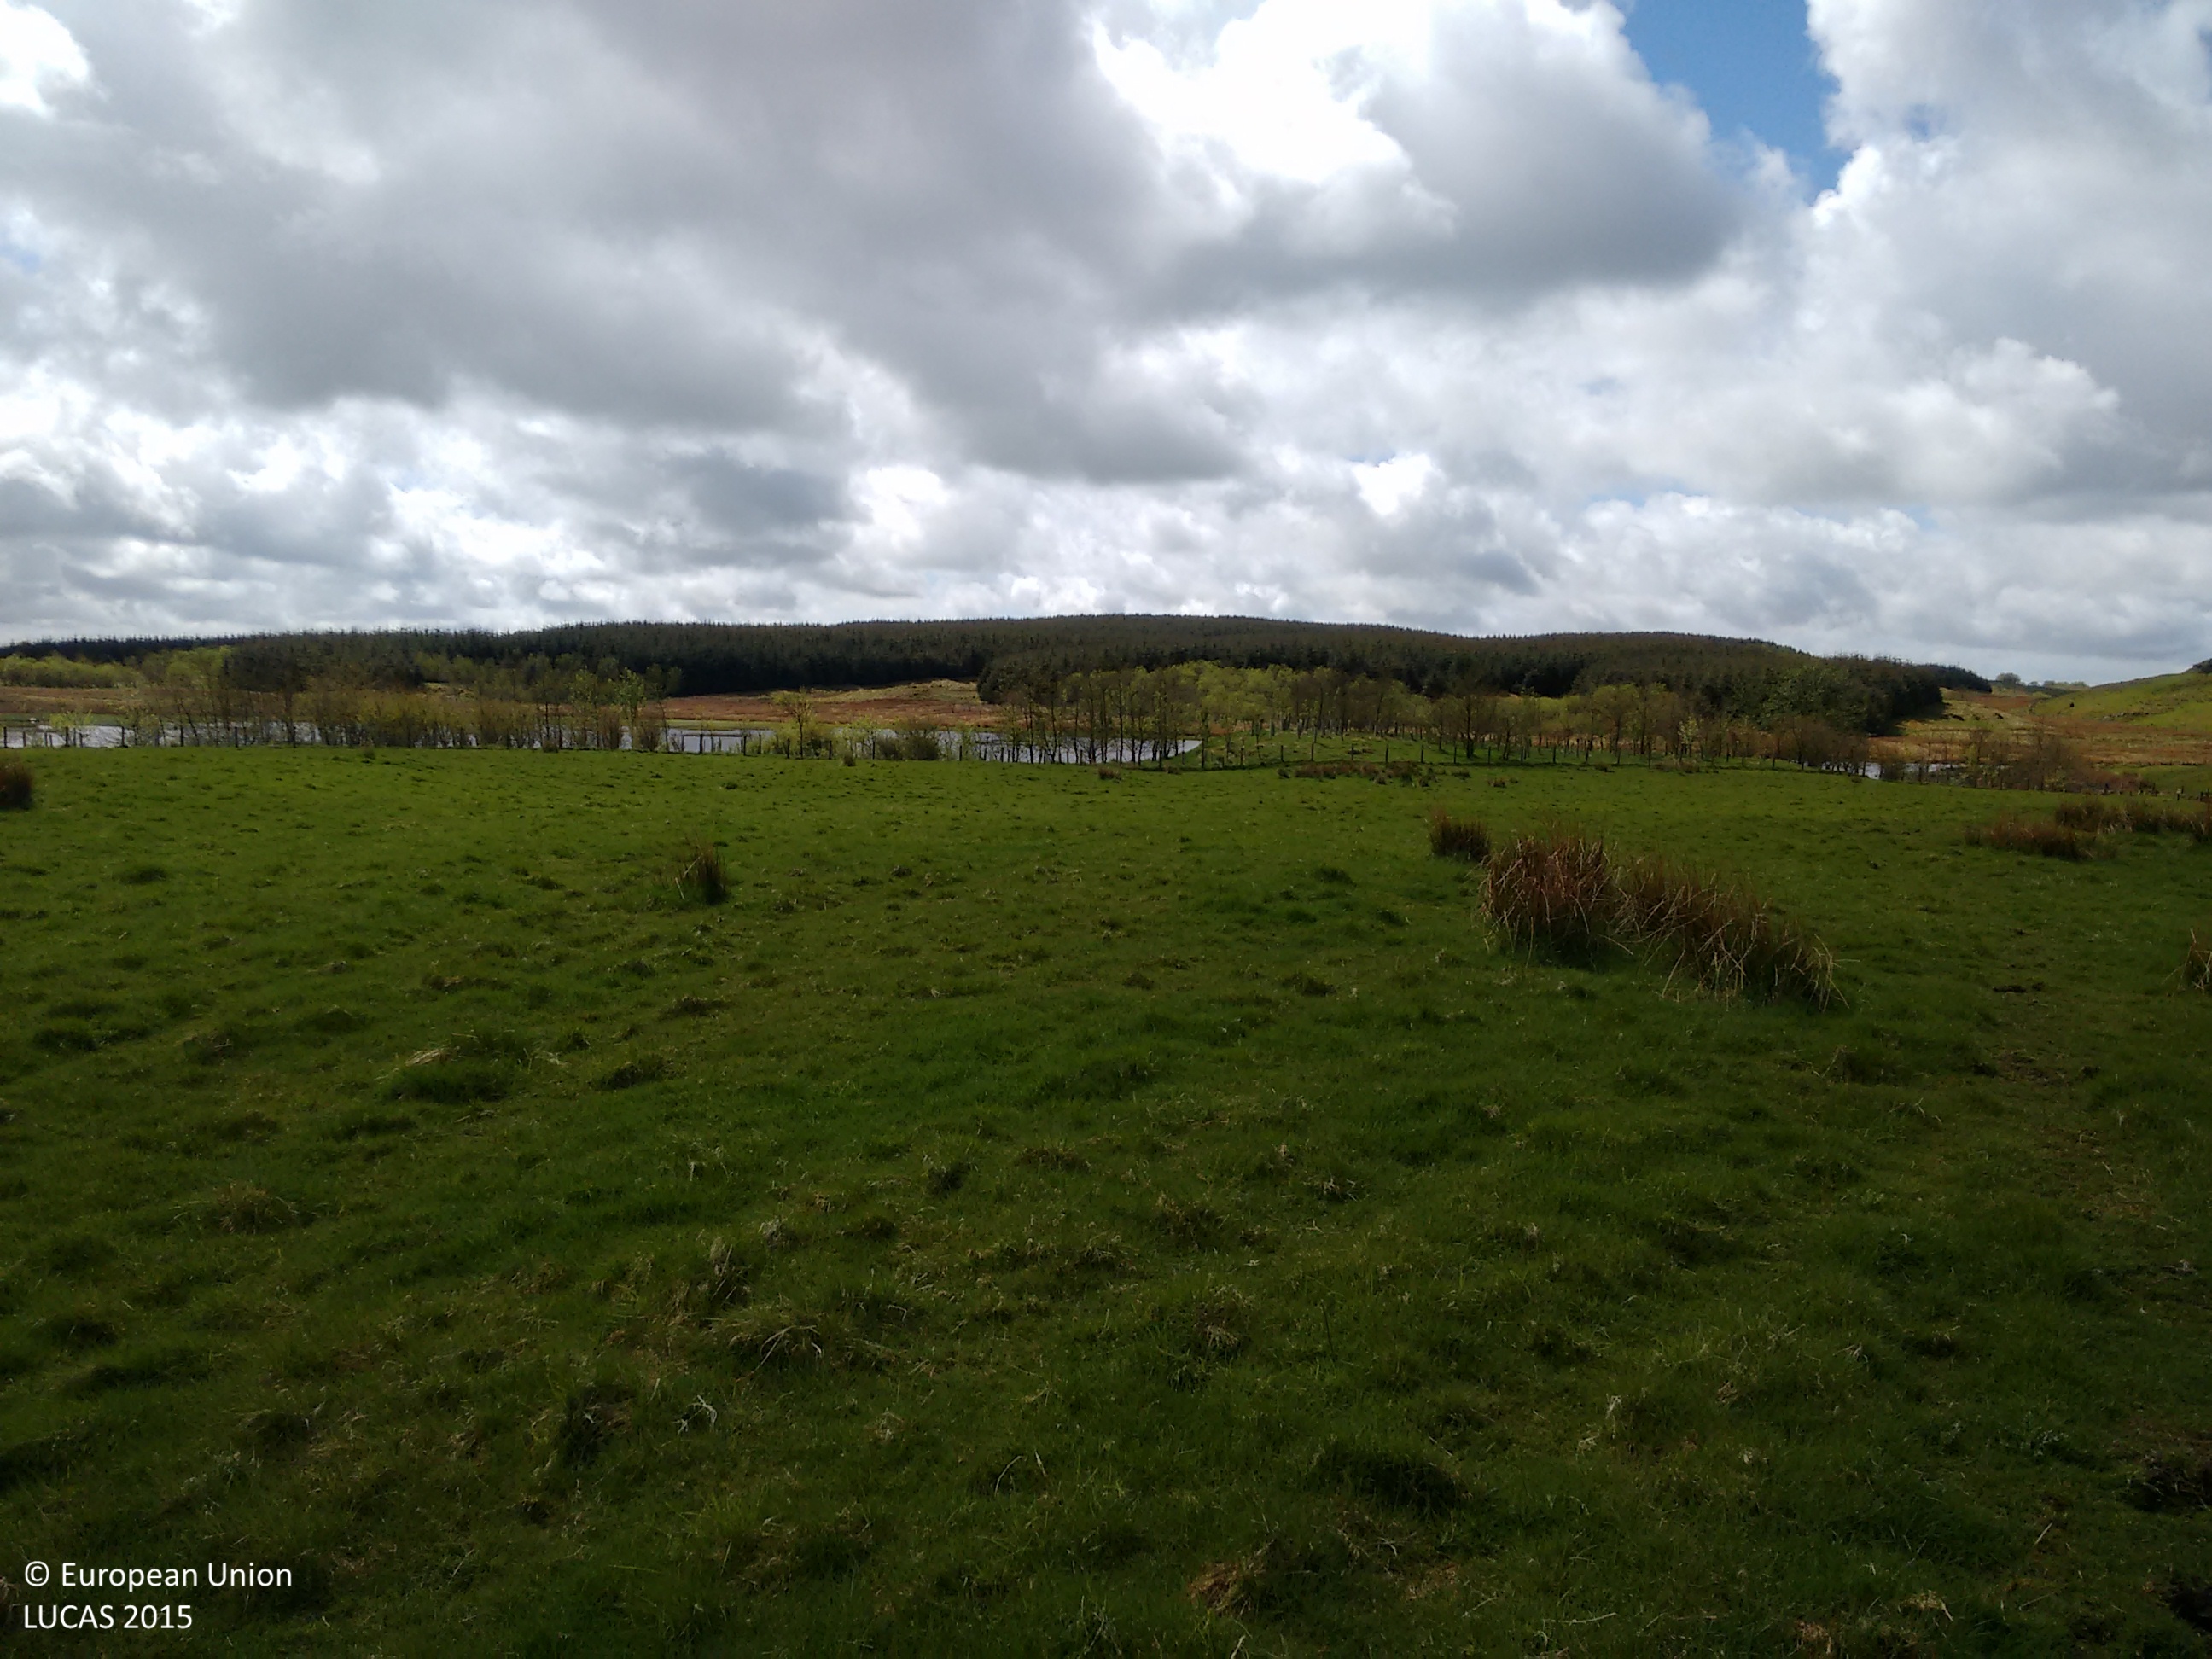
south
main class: Grassland
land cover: Grassland without tree/shrub cover
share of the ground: > 75 %
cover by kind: herbaceous plants 100 %
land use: Agriculture (excluding fallow land and kitchen gardens)
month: May
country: GB
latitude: 55.7478
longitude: -4.4519
